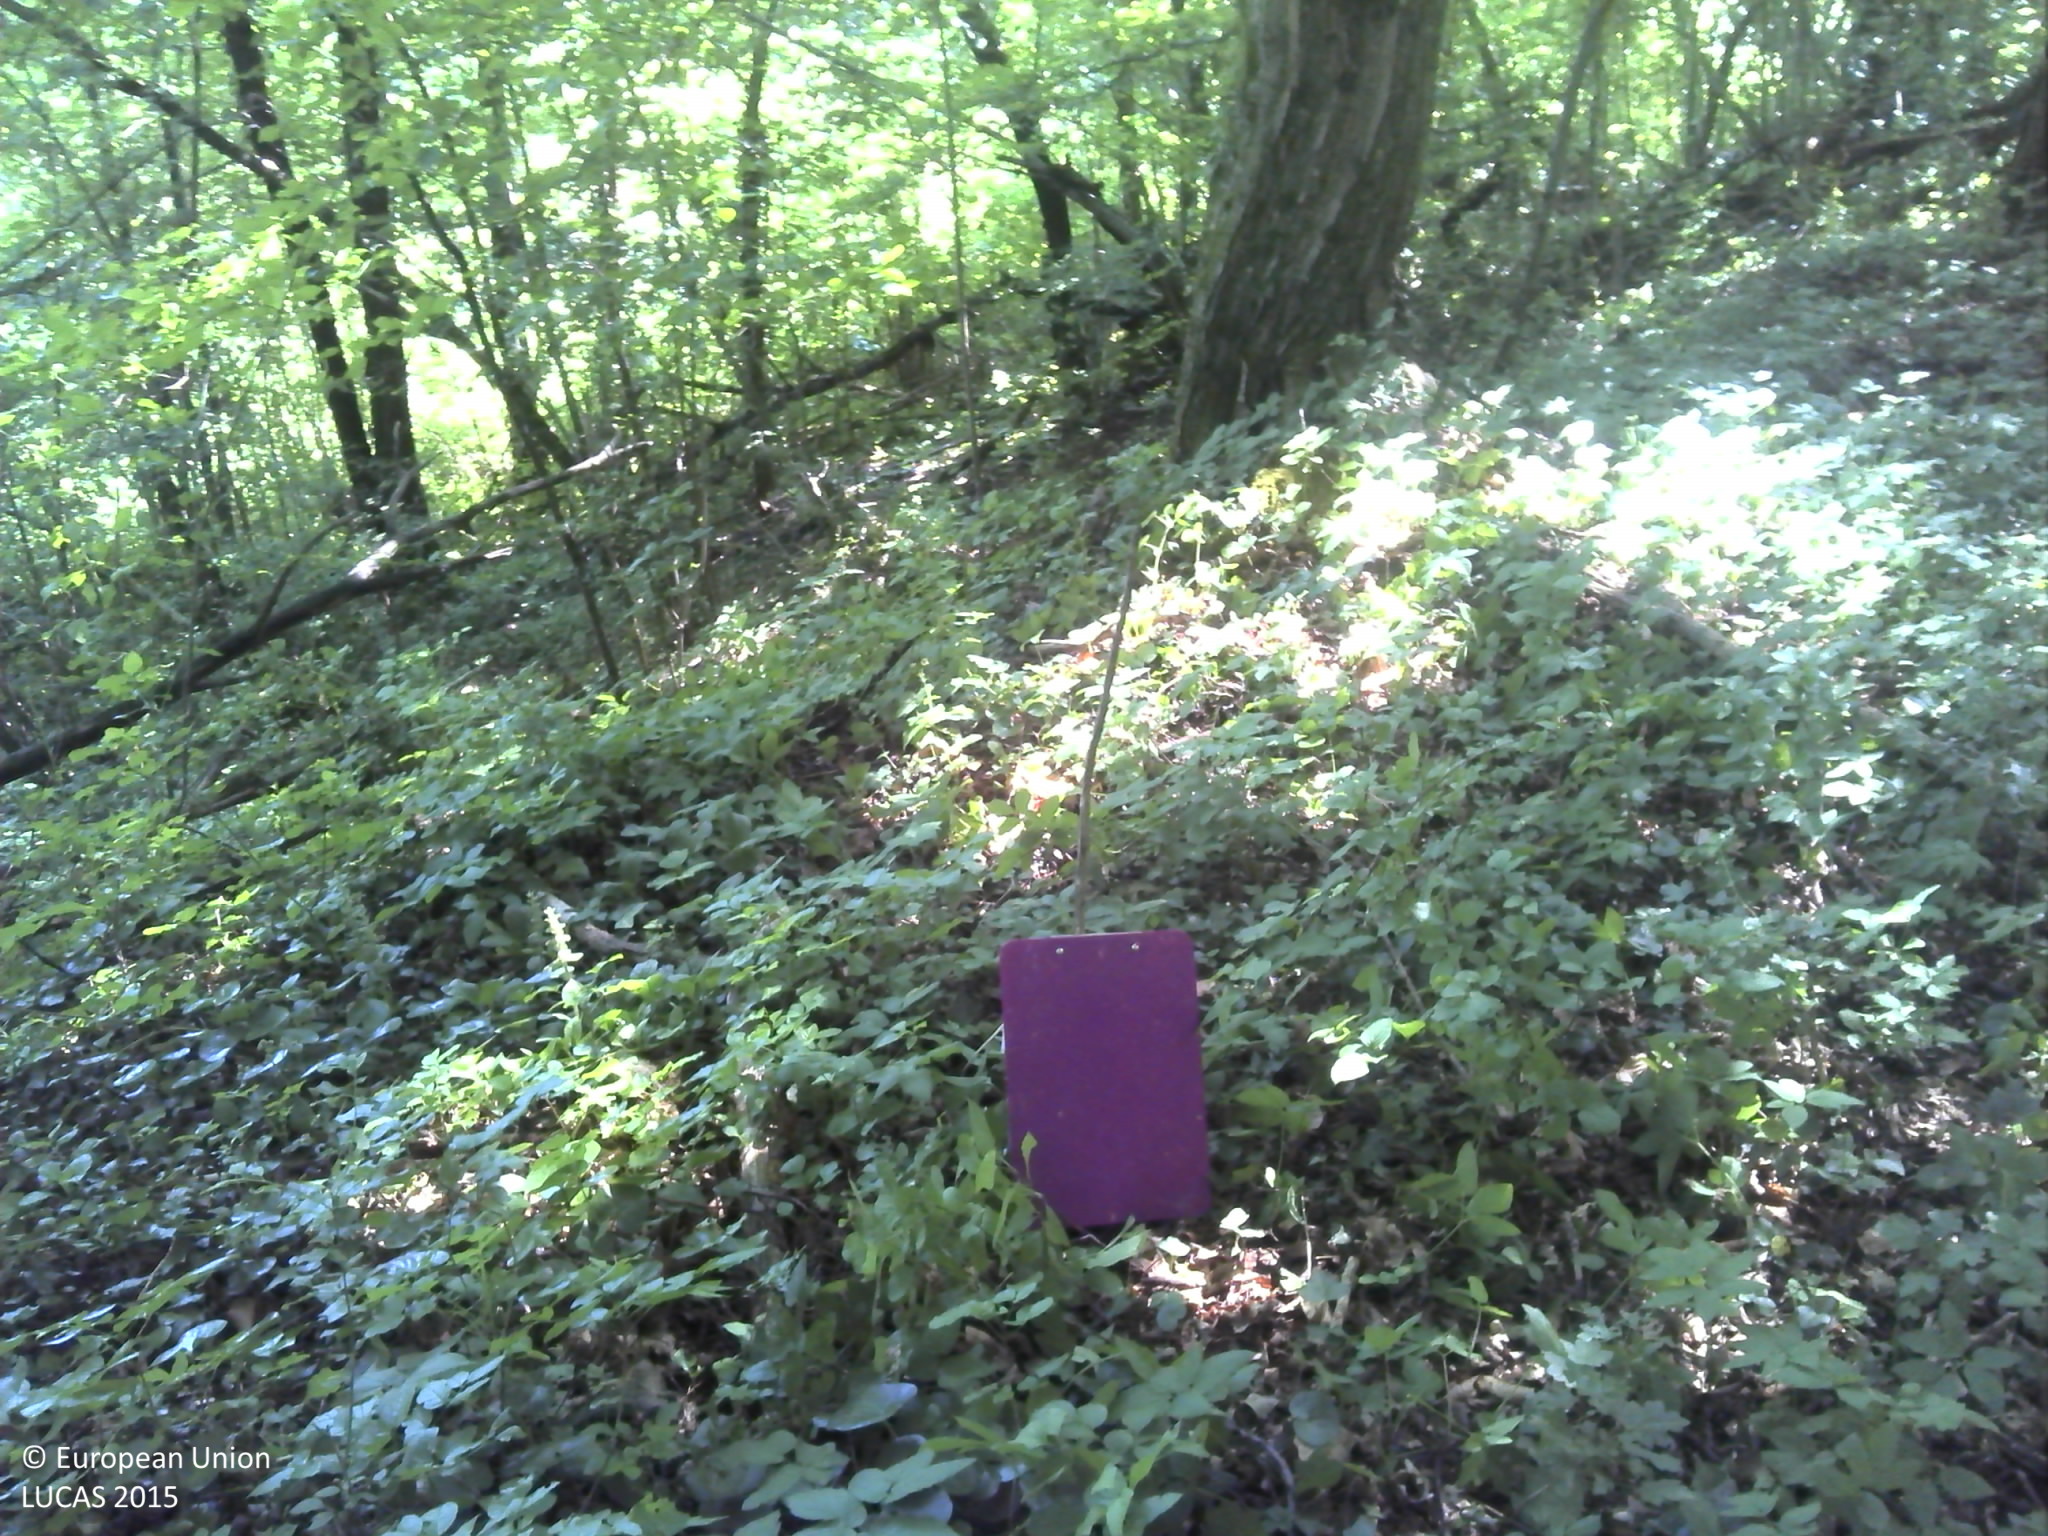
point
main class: Woodland
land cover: Broadleaved woodland
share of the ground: > 75 %
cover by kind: broadleaved forest trees 80 %, lichens and mosses 20 %
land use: Forestry
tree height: < 5 m
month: June
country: HR
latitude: 45.4198
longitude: 17.2206
